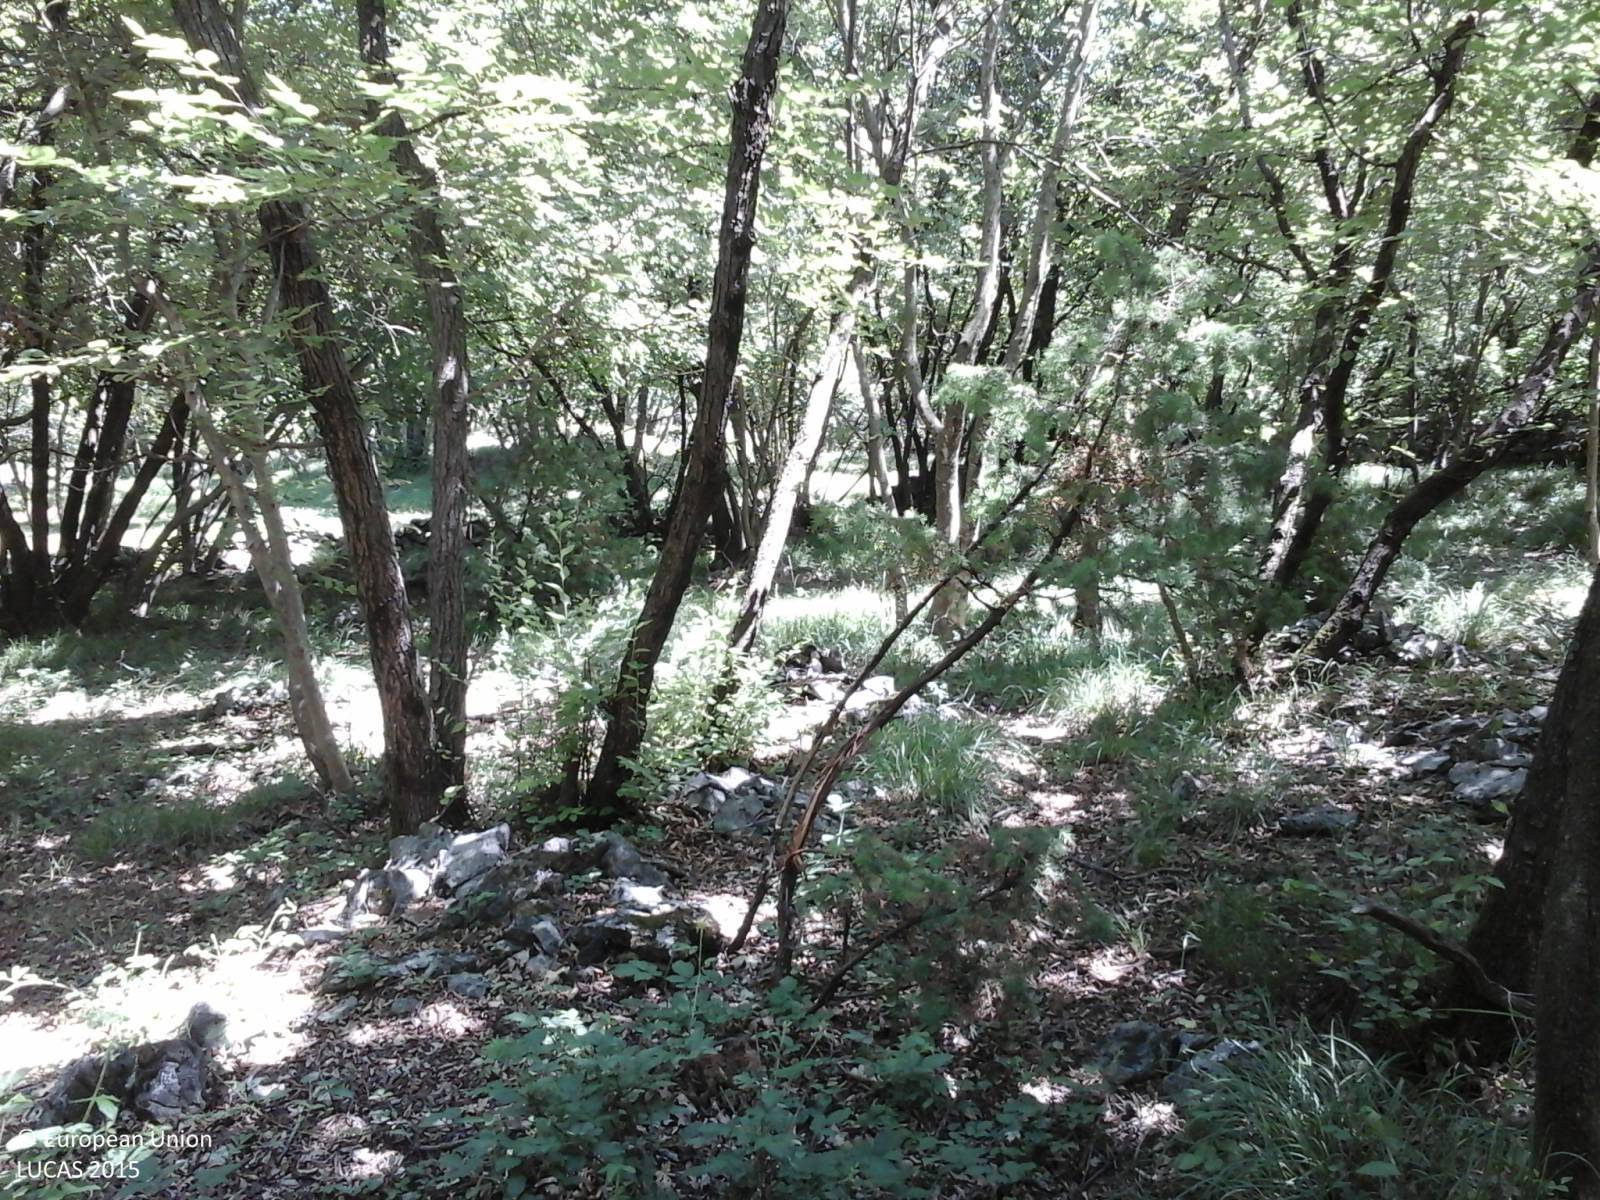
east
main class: Woodland
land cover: Broadleaved woodland
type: thermophilous deciduous forest
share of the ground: > 75 %
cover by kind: broadleaved forest trees 90 %, shrubs 10 %
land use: Forestry
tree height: > 5 m
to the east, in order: Broadleaved woodland; Dry stone walls; Broadleaved woodland; Fences; Paved roads, cycling and walking lanes; Dry stone walls; Broadleaved woodland; Dry stone walls; Paved roads, cycling and walking lanes; Dry stone walls; Broadleaved woodland; Dry stone walls; Grassland without tree/shrub cover; Tracks; Grassland without tree/shrub cover
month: June
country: IT
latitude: 45.7845
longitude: 13.6360
